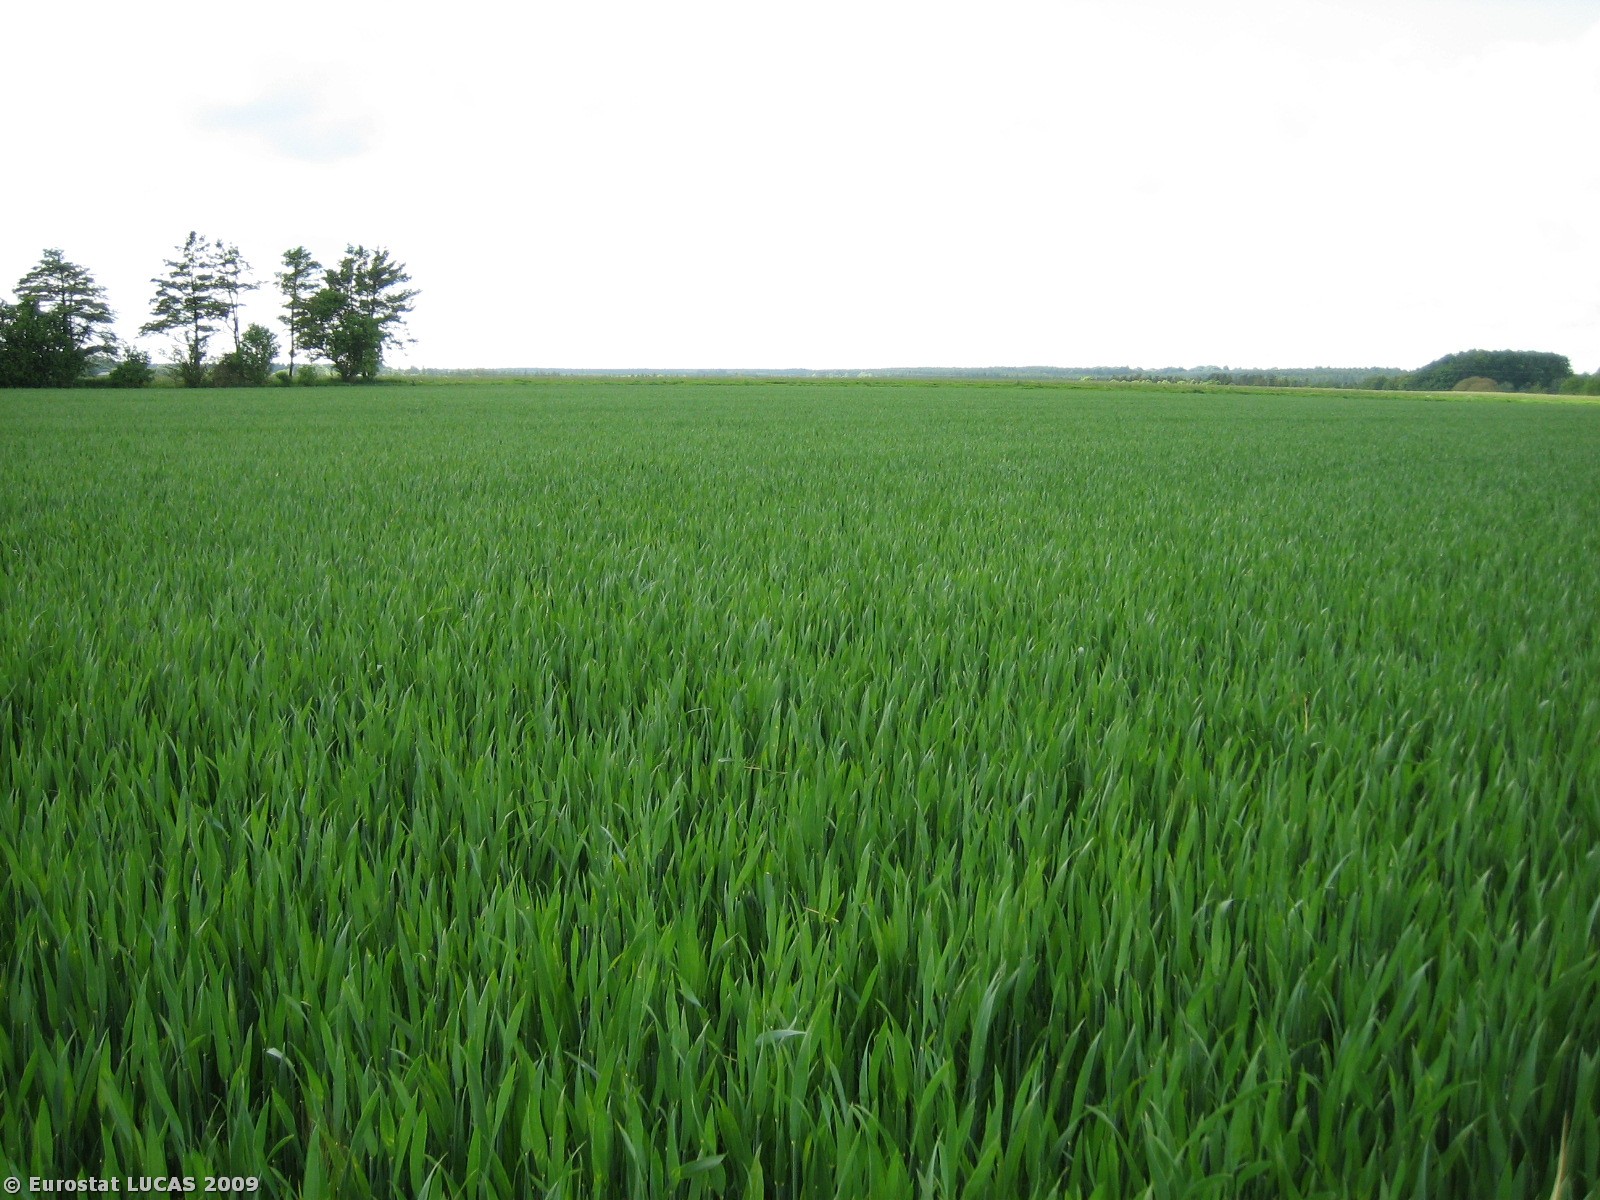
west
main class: Cropland
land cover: Barley
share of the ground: > 75 %
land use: Agriculture (excluding fallow land and kitchen gardens)
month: May
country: DK
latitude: 56.0206
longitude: 8.8301
